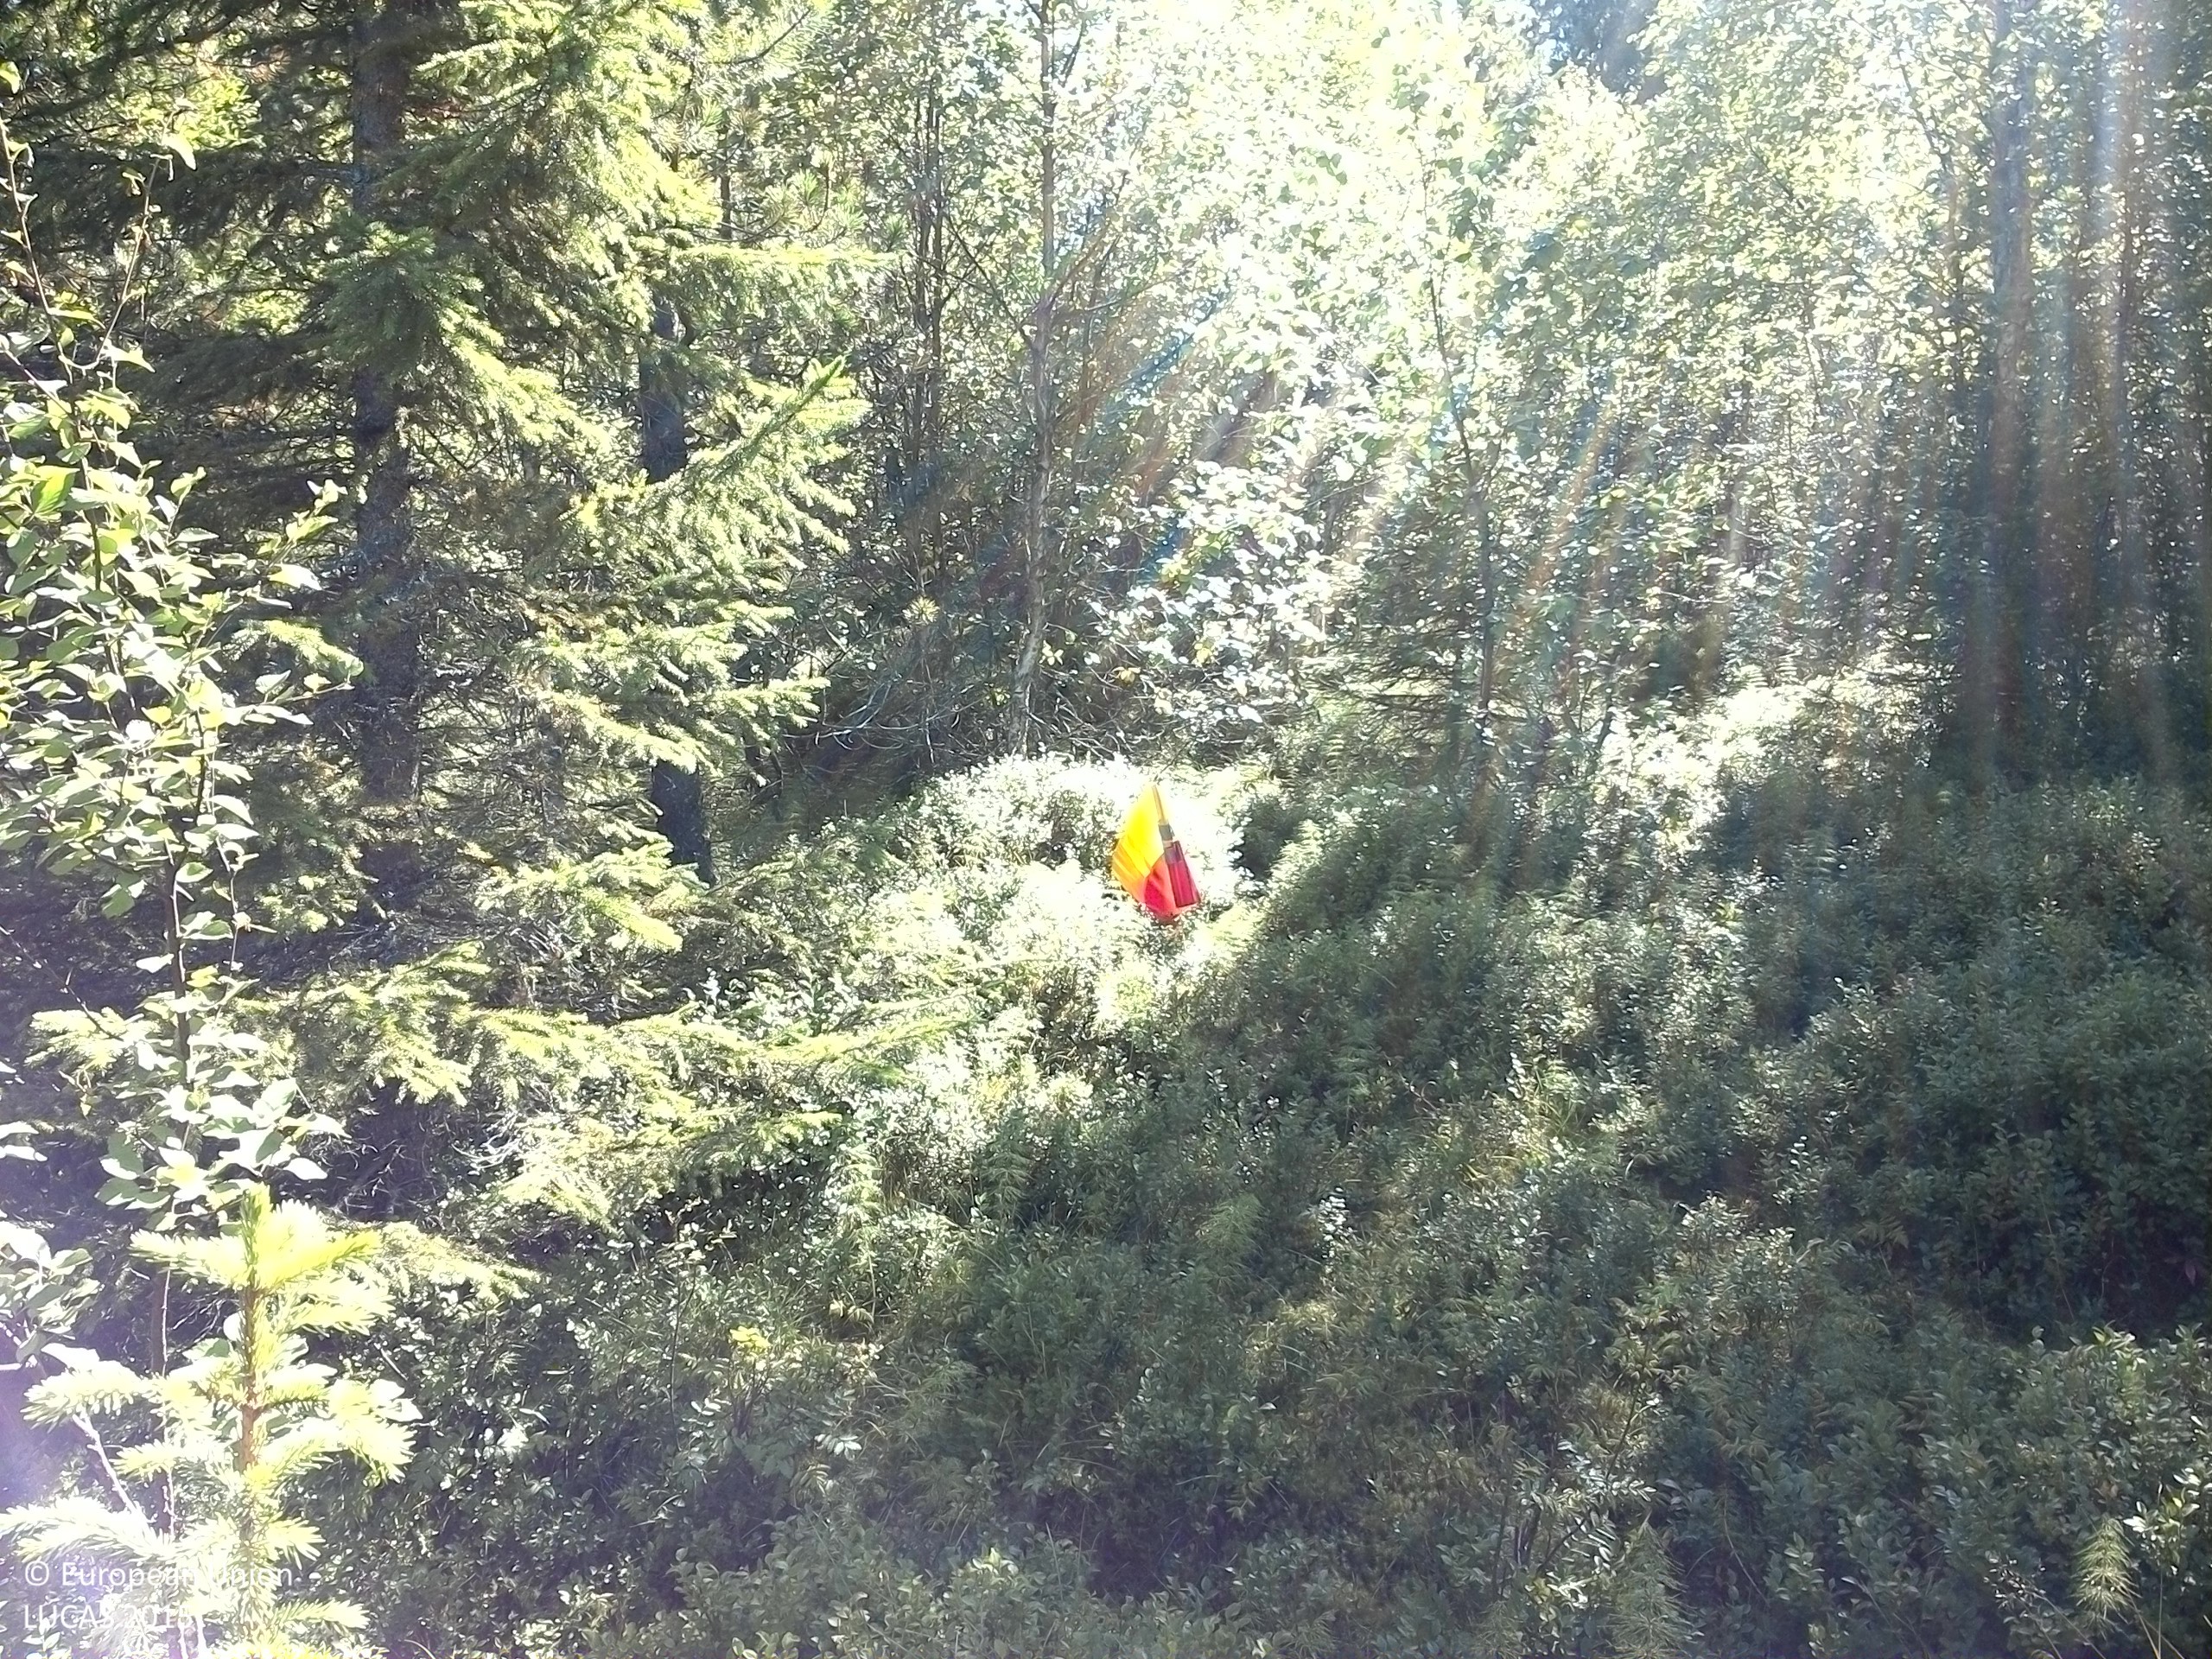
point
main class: Woodland
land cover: Spruce dominated mixed woodland
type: boreal forest
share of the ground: 50 - 75 %
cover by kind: coniferous forest trees 35 %, broadleaved forest trees 30 %, shrubs 25 %, lichens and mosses 10 %
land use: Forestry
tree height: > 5 m
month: August
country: SE
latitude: 63.9439
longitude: 16.8066
